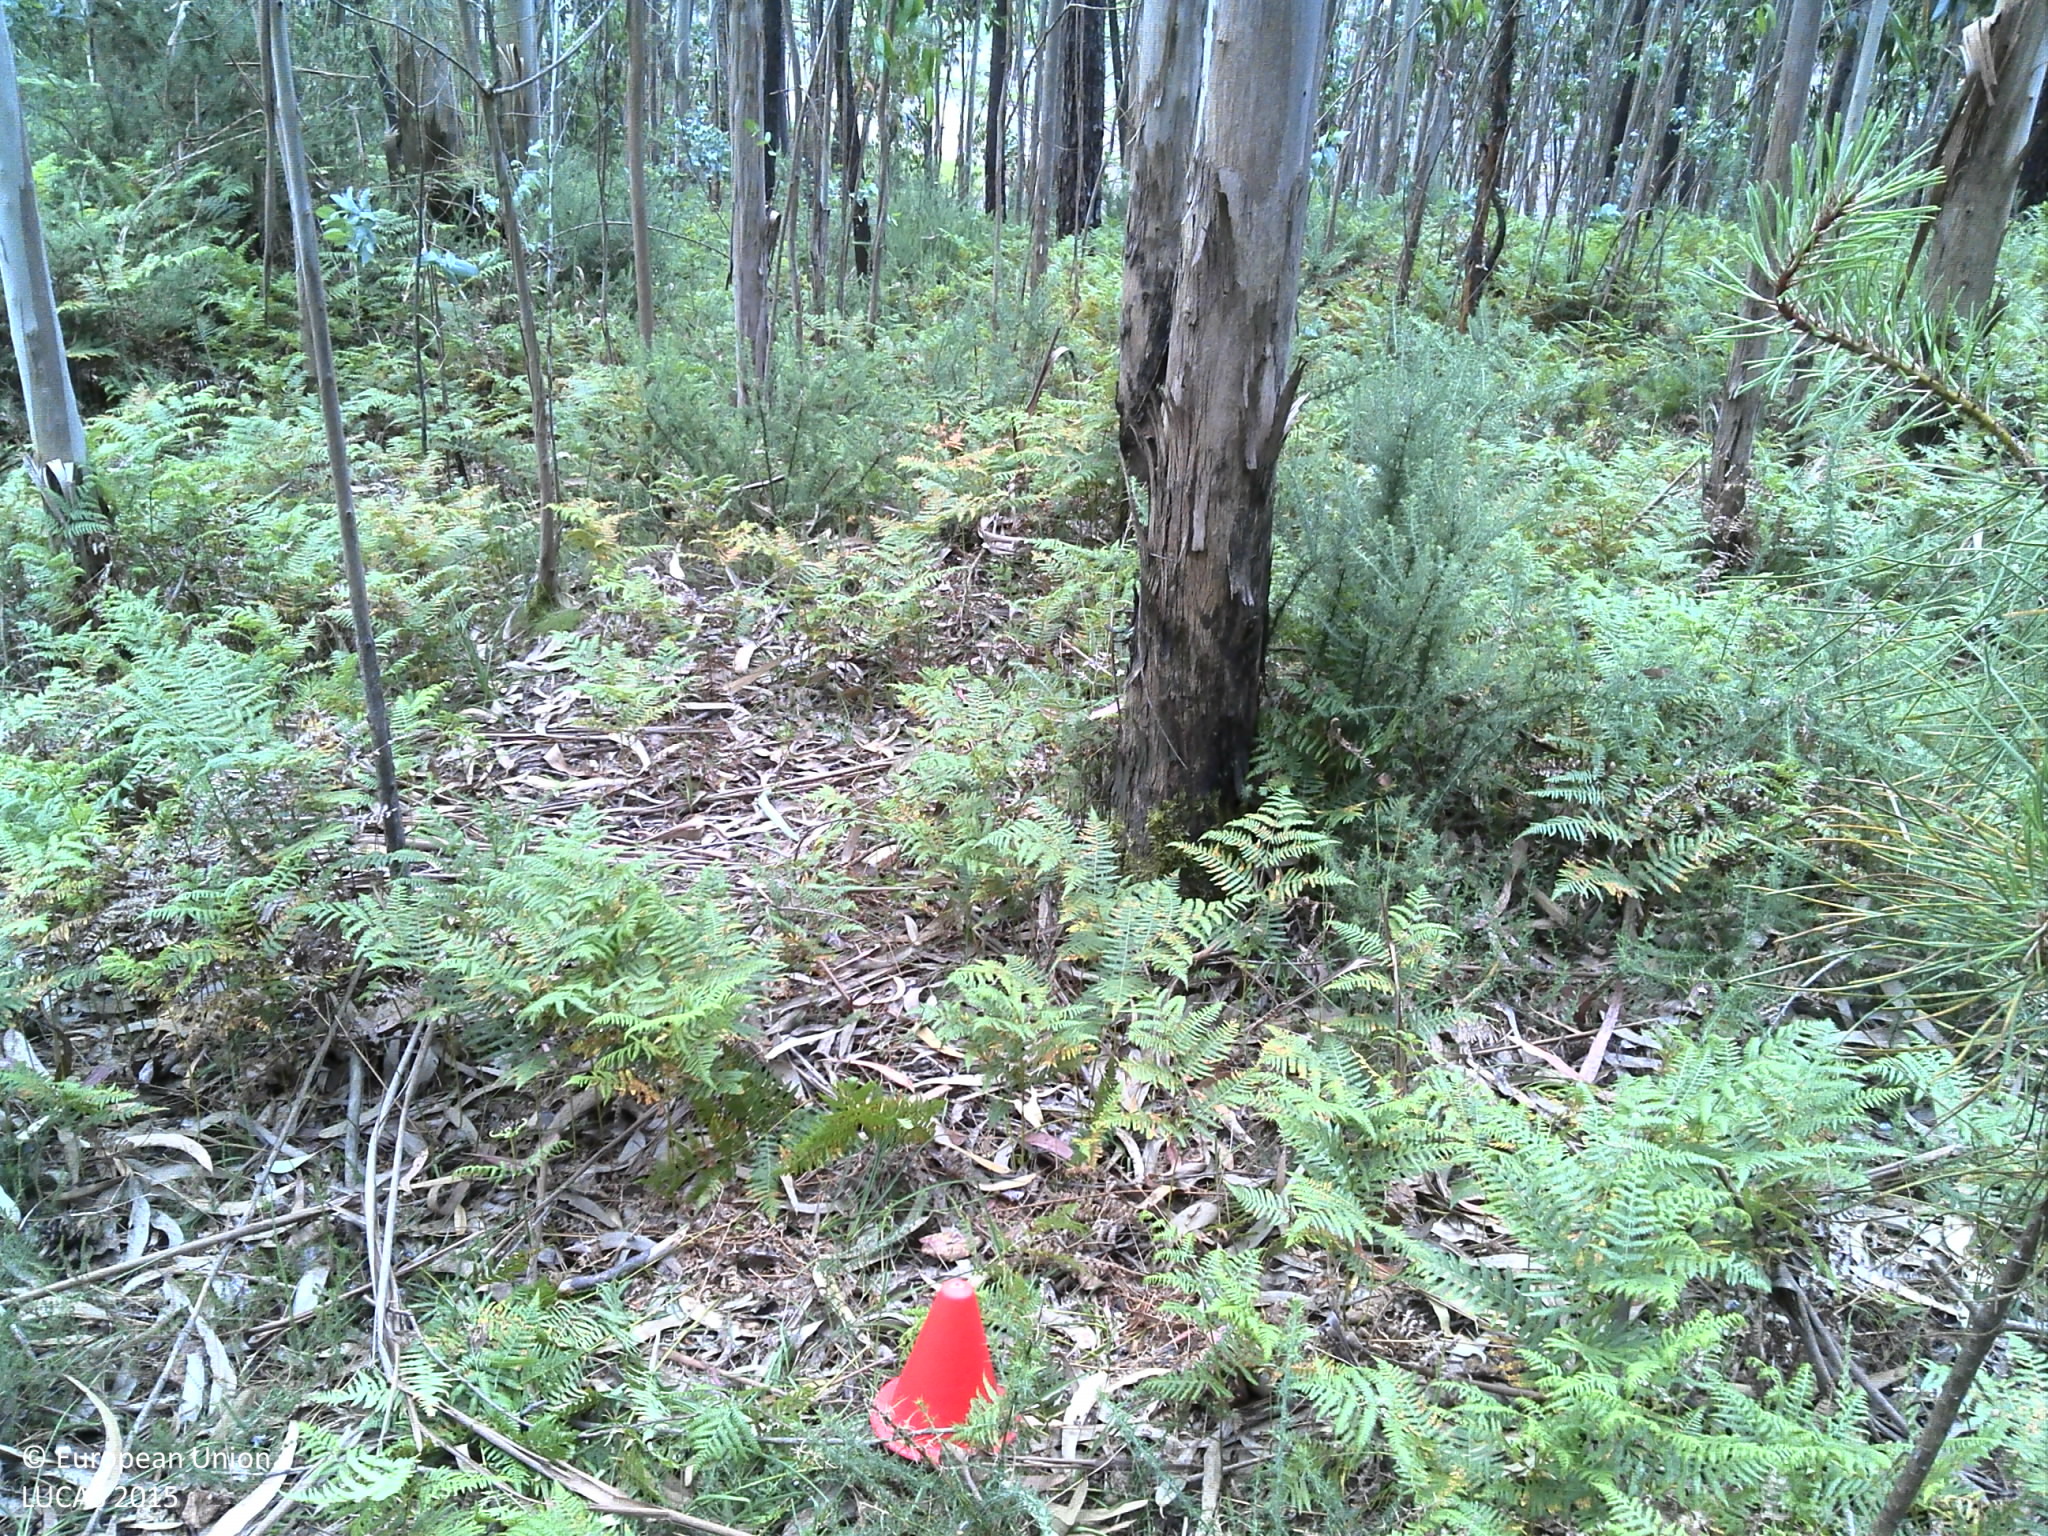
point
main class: Woodland
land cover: Broadleaved woodland
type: exotic forest
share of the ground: > 75 %
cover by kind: broadleaved forest trees 70 %, shrubs 20 %, herbaceous plants 5 %, unconsolidated bare surface 5 %
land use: Forestry
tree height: > 5 m
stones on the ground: < 10 %
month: May
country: PT
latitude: 41.4571
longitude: -8.6553
